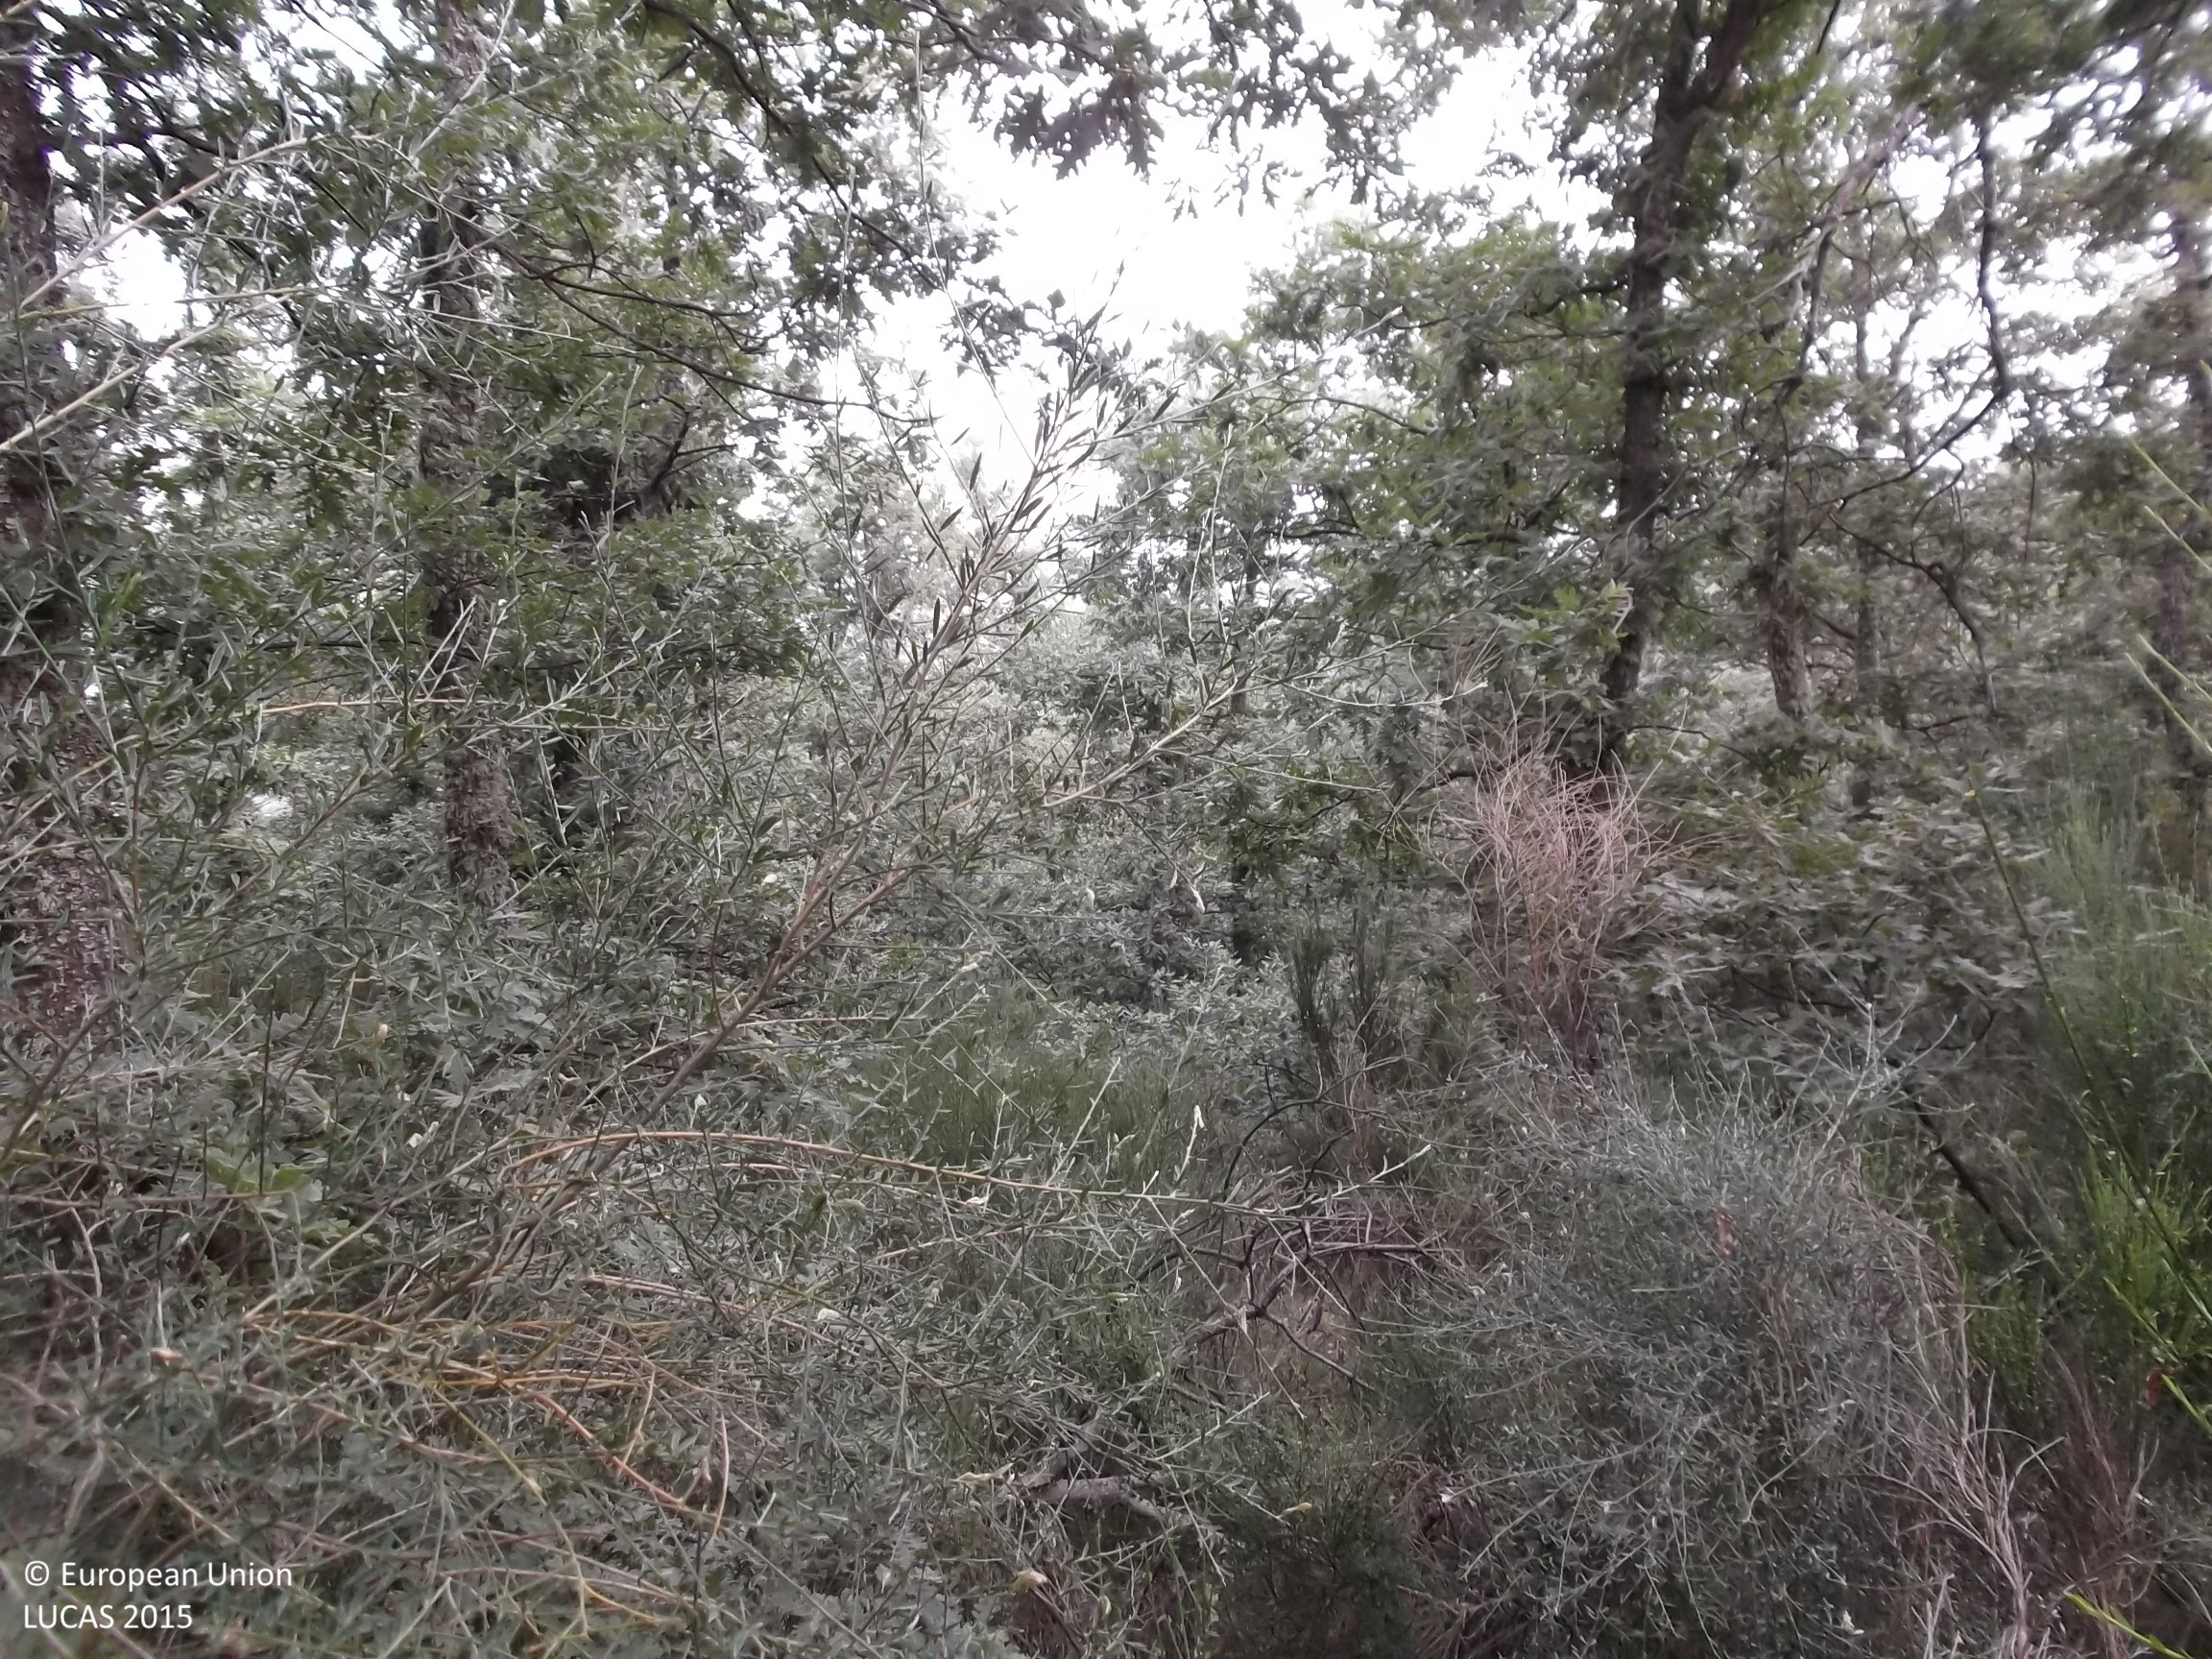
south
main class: Woodland
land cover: Broadleaved woodland
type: thermophilous deciduous forest
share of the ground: > 75 %
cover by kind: broadleaved forest trees 95 %
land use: Semi-natural and natural areas not in use
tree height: > 5 m
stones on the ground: < 10 %
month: July
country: ES
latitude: 42.3742
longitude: -3.0335
